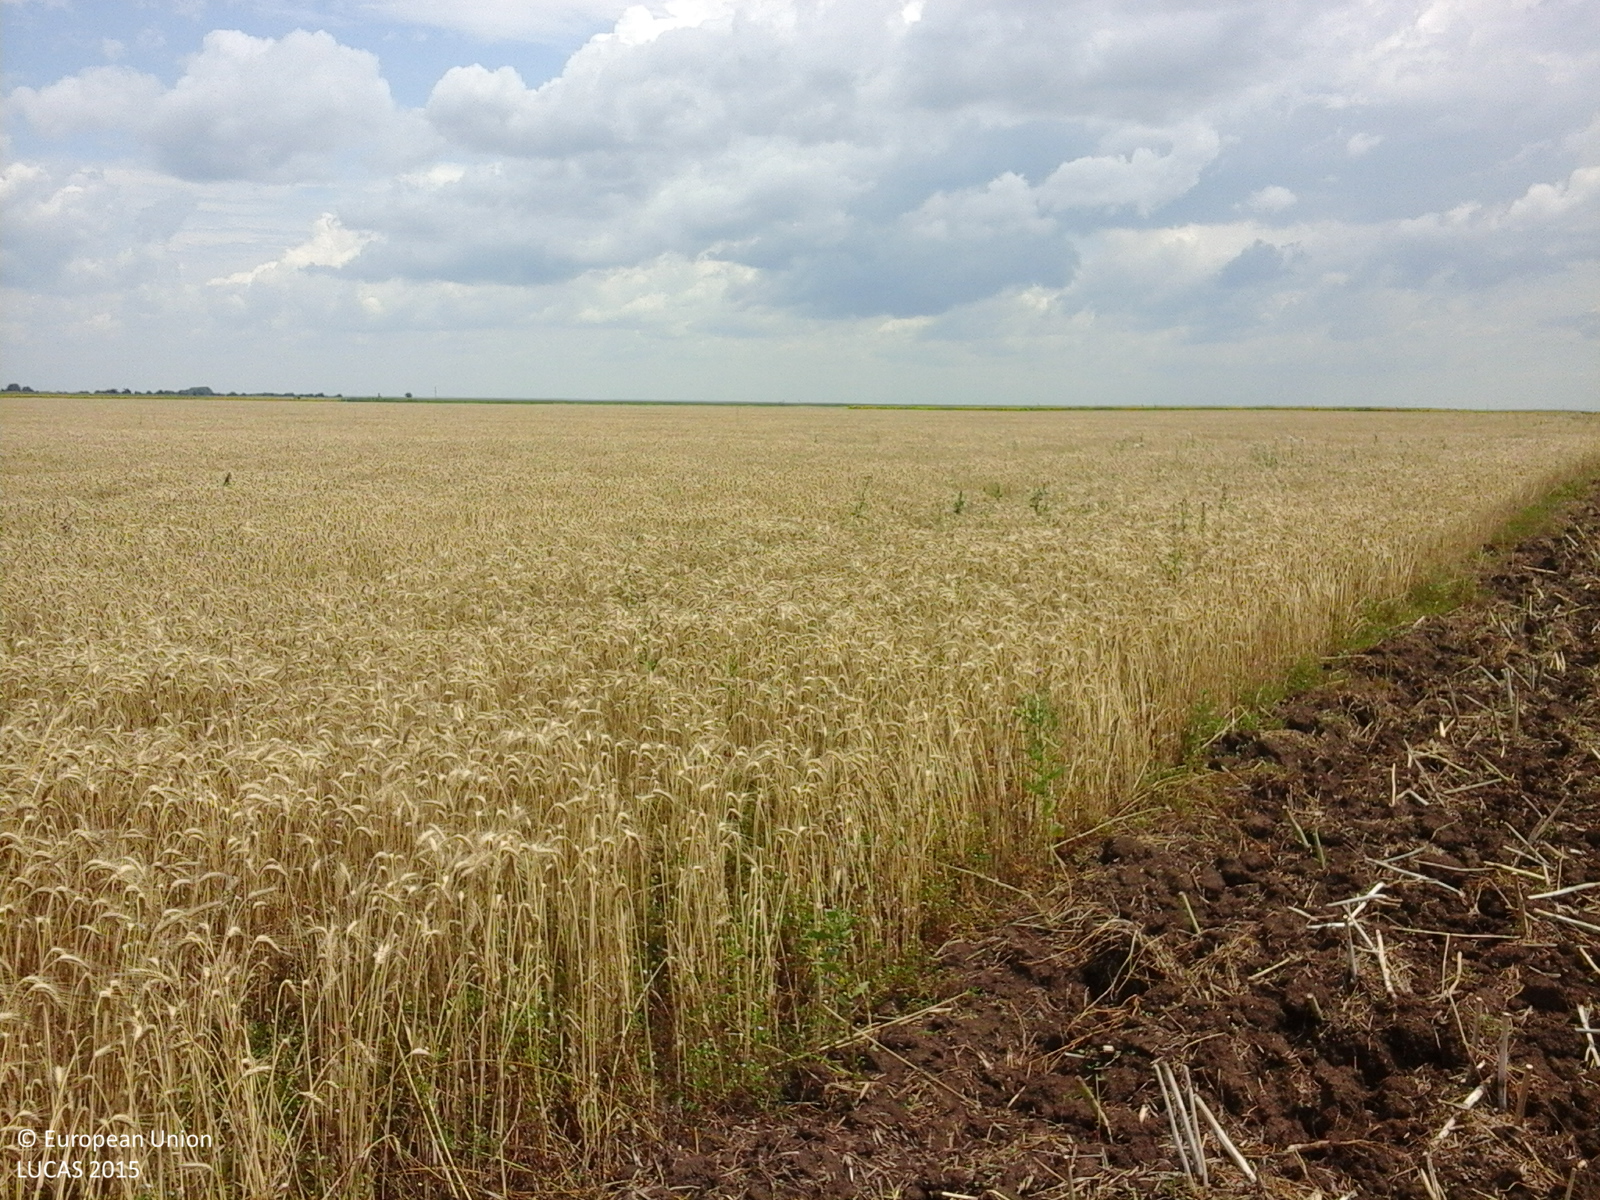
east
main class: Cropland
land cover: Common wheat
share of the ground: > 75 %
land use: Agriculture (excluding fallow land and kitchen gardens)
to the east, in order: Common wheat
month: July
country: RO
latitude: 43.8937
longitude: 24.3665
